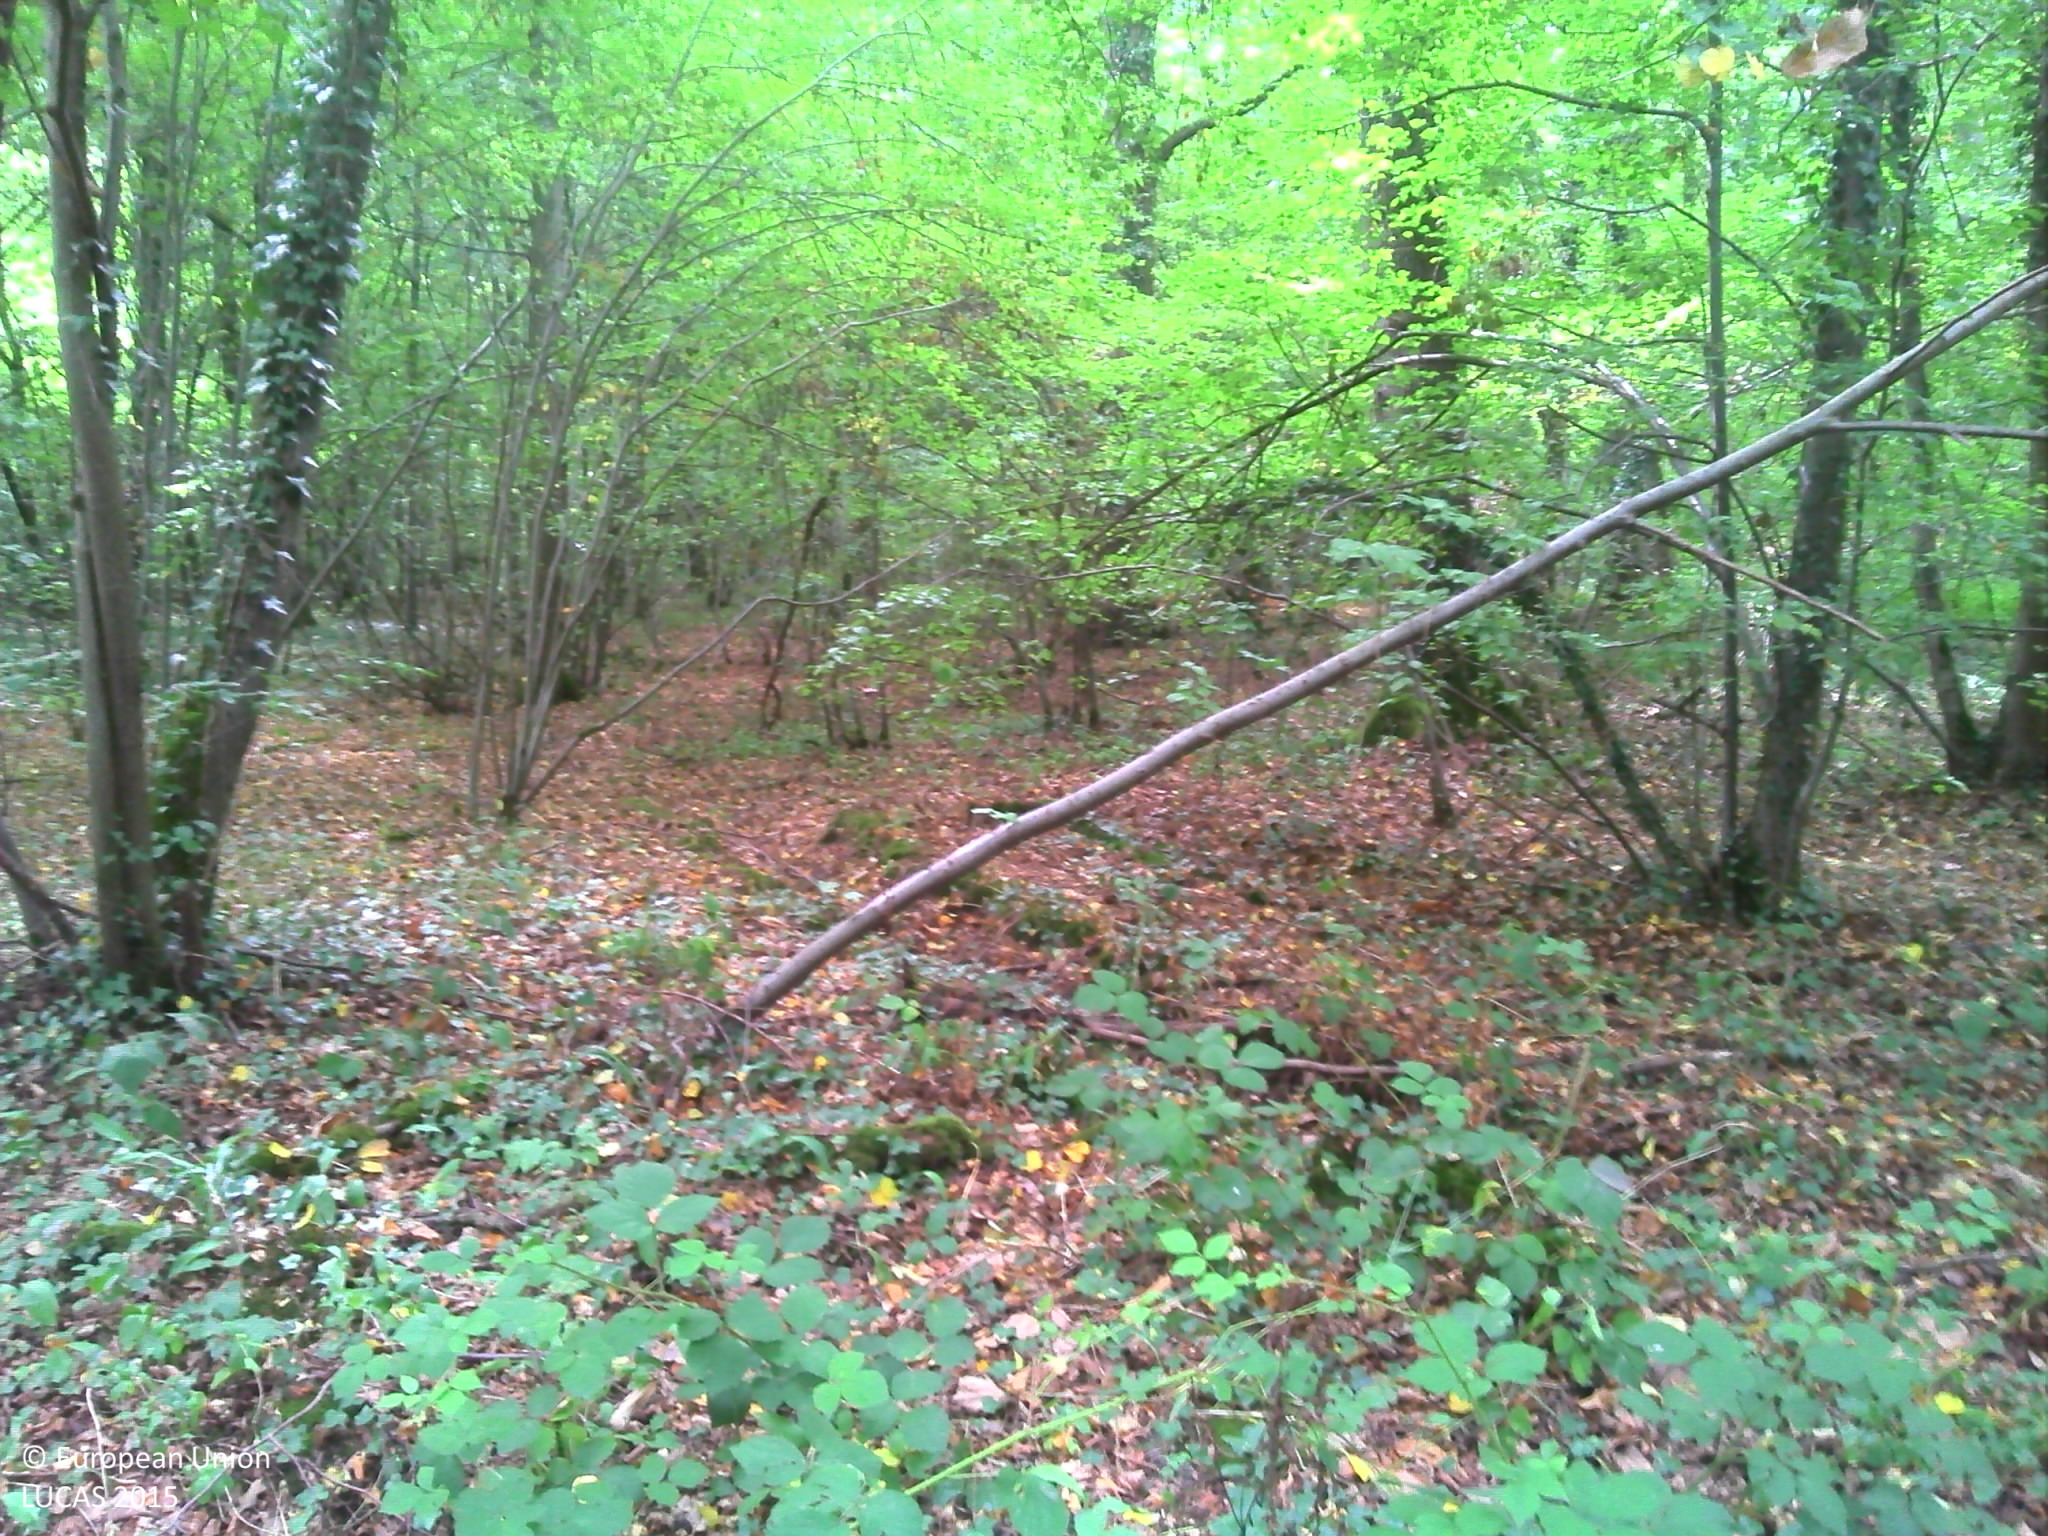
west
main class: Woodland
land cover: Broadleaved woodland
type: hemiboreal forest and nemoral coniferous forest and mixed broadleaved-coniferous forest
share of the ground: > 75 %
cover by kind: broadleaved forest trees 60 %, herbaceous plants 20 %, lichens and mosses 10 %, unconsolidated bare surface 10 %
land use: Forestry
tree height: > 5 m
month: August
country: FR
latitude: 48.9021
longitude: 2.6912
